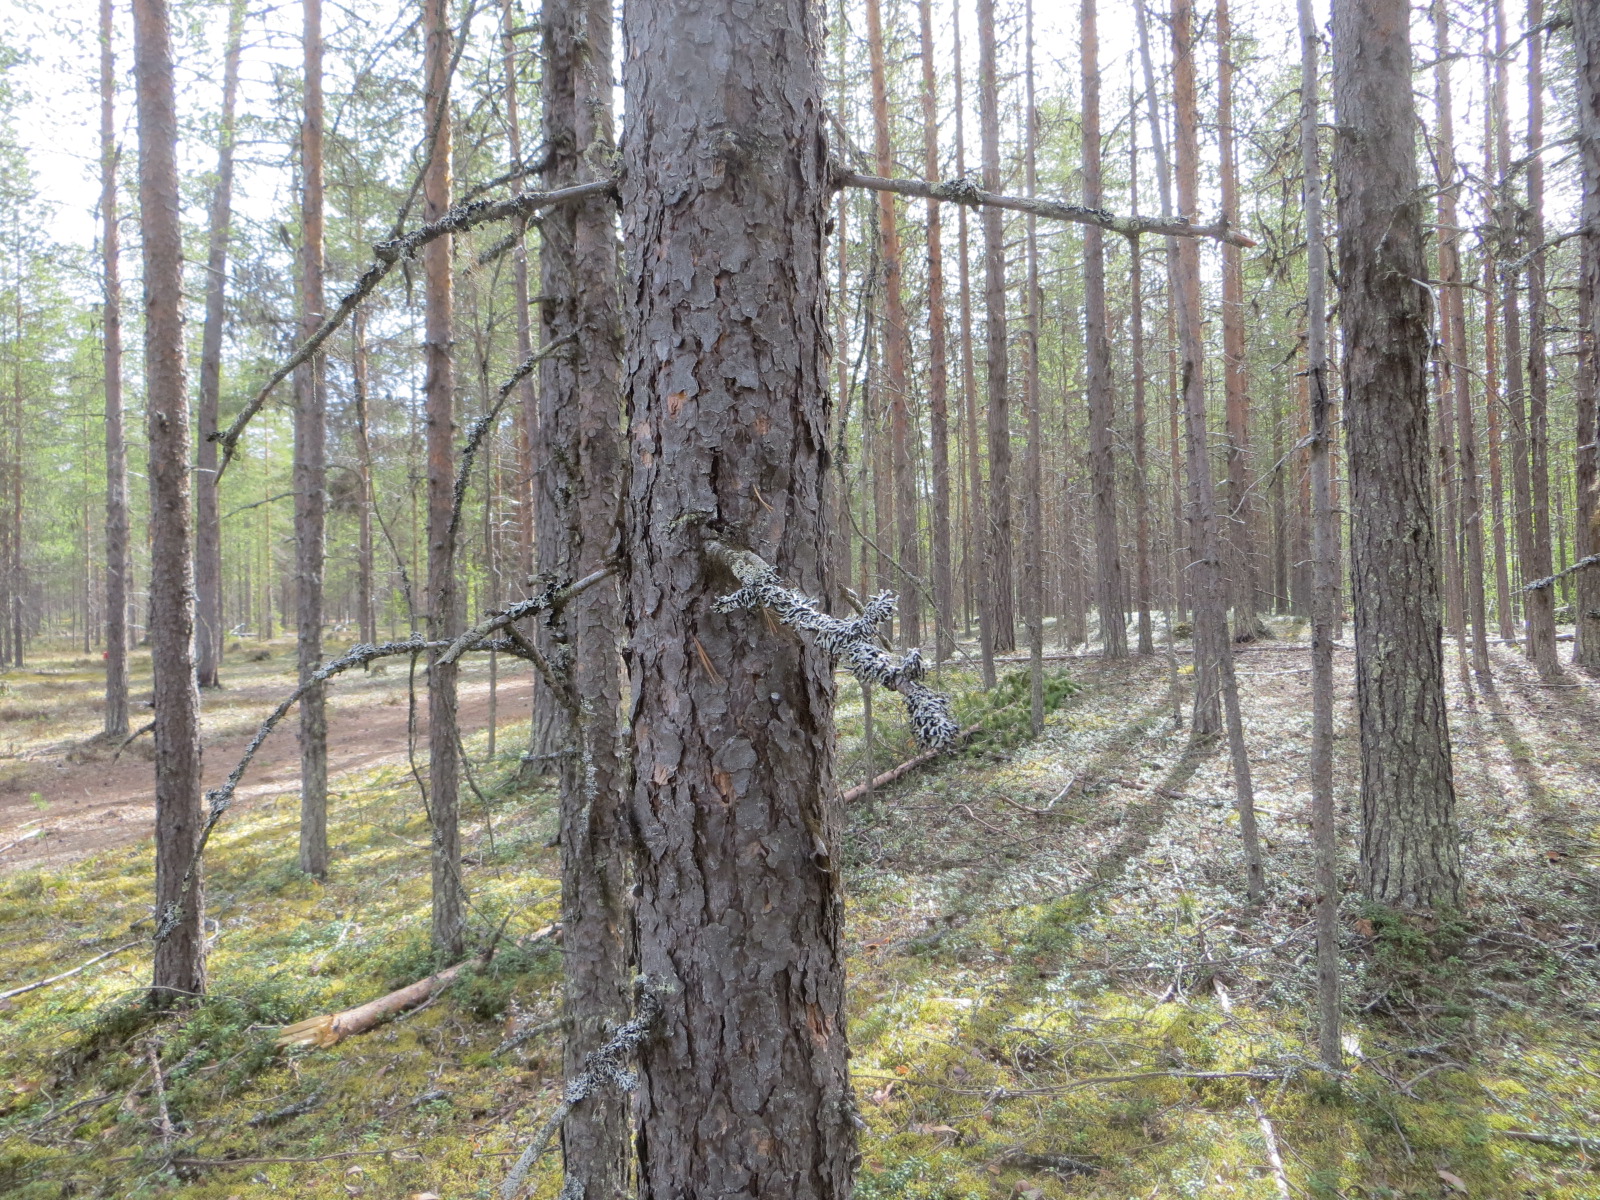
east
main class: Woodland
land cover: Pine dominated coniferous woodland
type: boreal forest
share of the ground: > 75 %
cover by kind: coniferous forest trees 90 %, shrubs 10 %
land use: Forestry
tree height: > 5 m
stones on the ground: < 10 %
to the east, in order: Pine dominated coniferous woodland; Tracks; Pine dominated coniferous woodland; Pine dominated mixed woodland
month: June
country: FI
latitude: 67.5407
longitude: 25.8898
